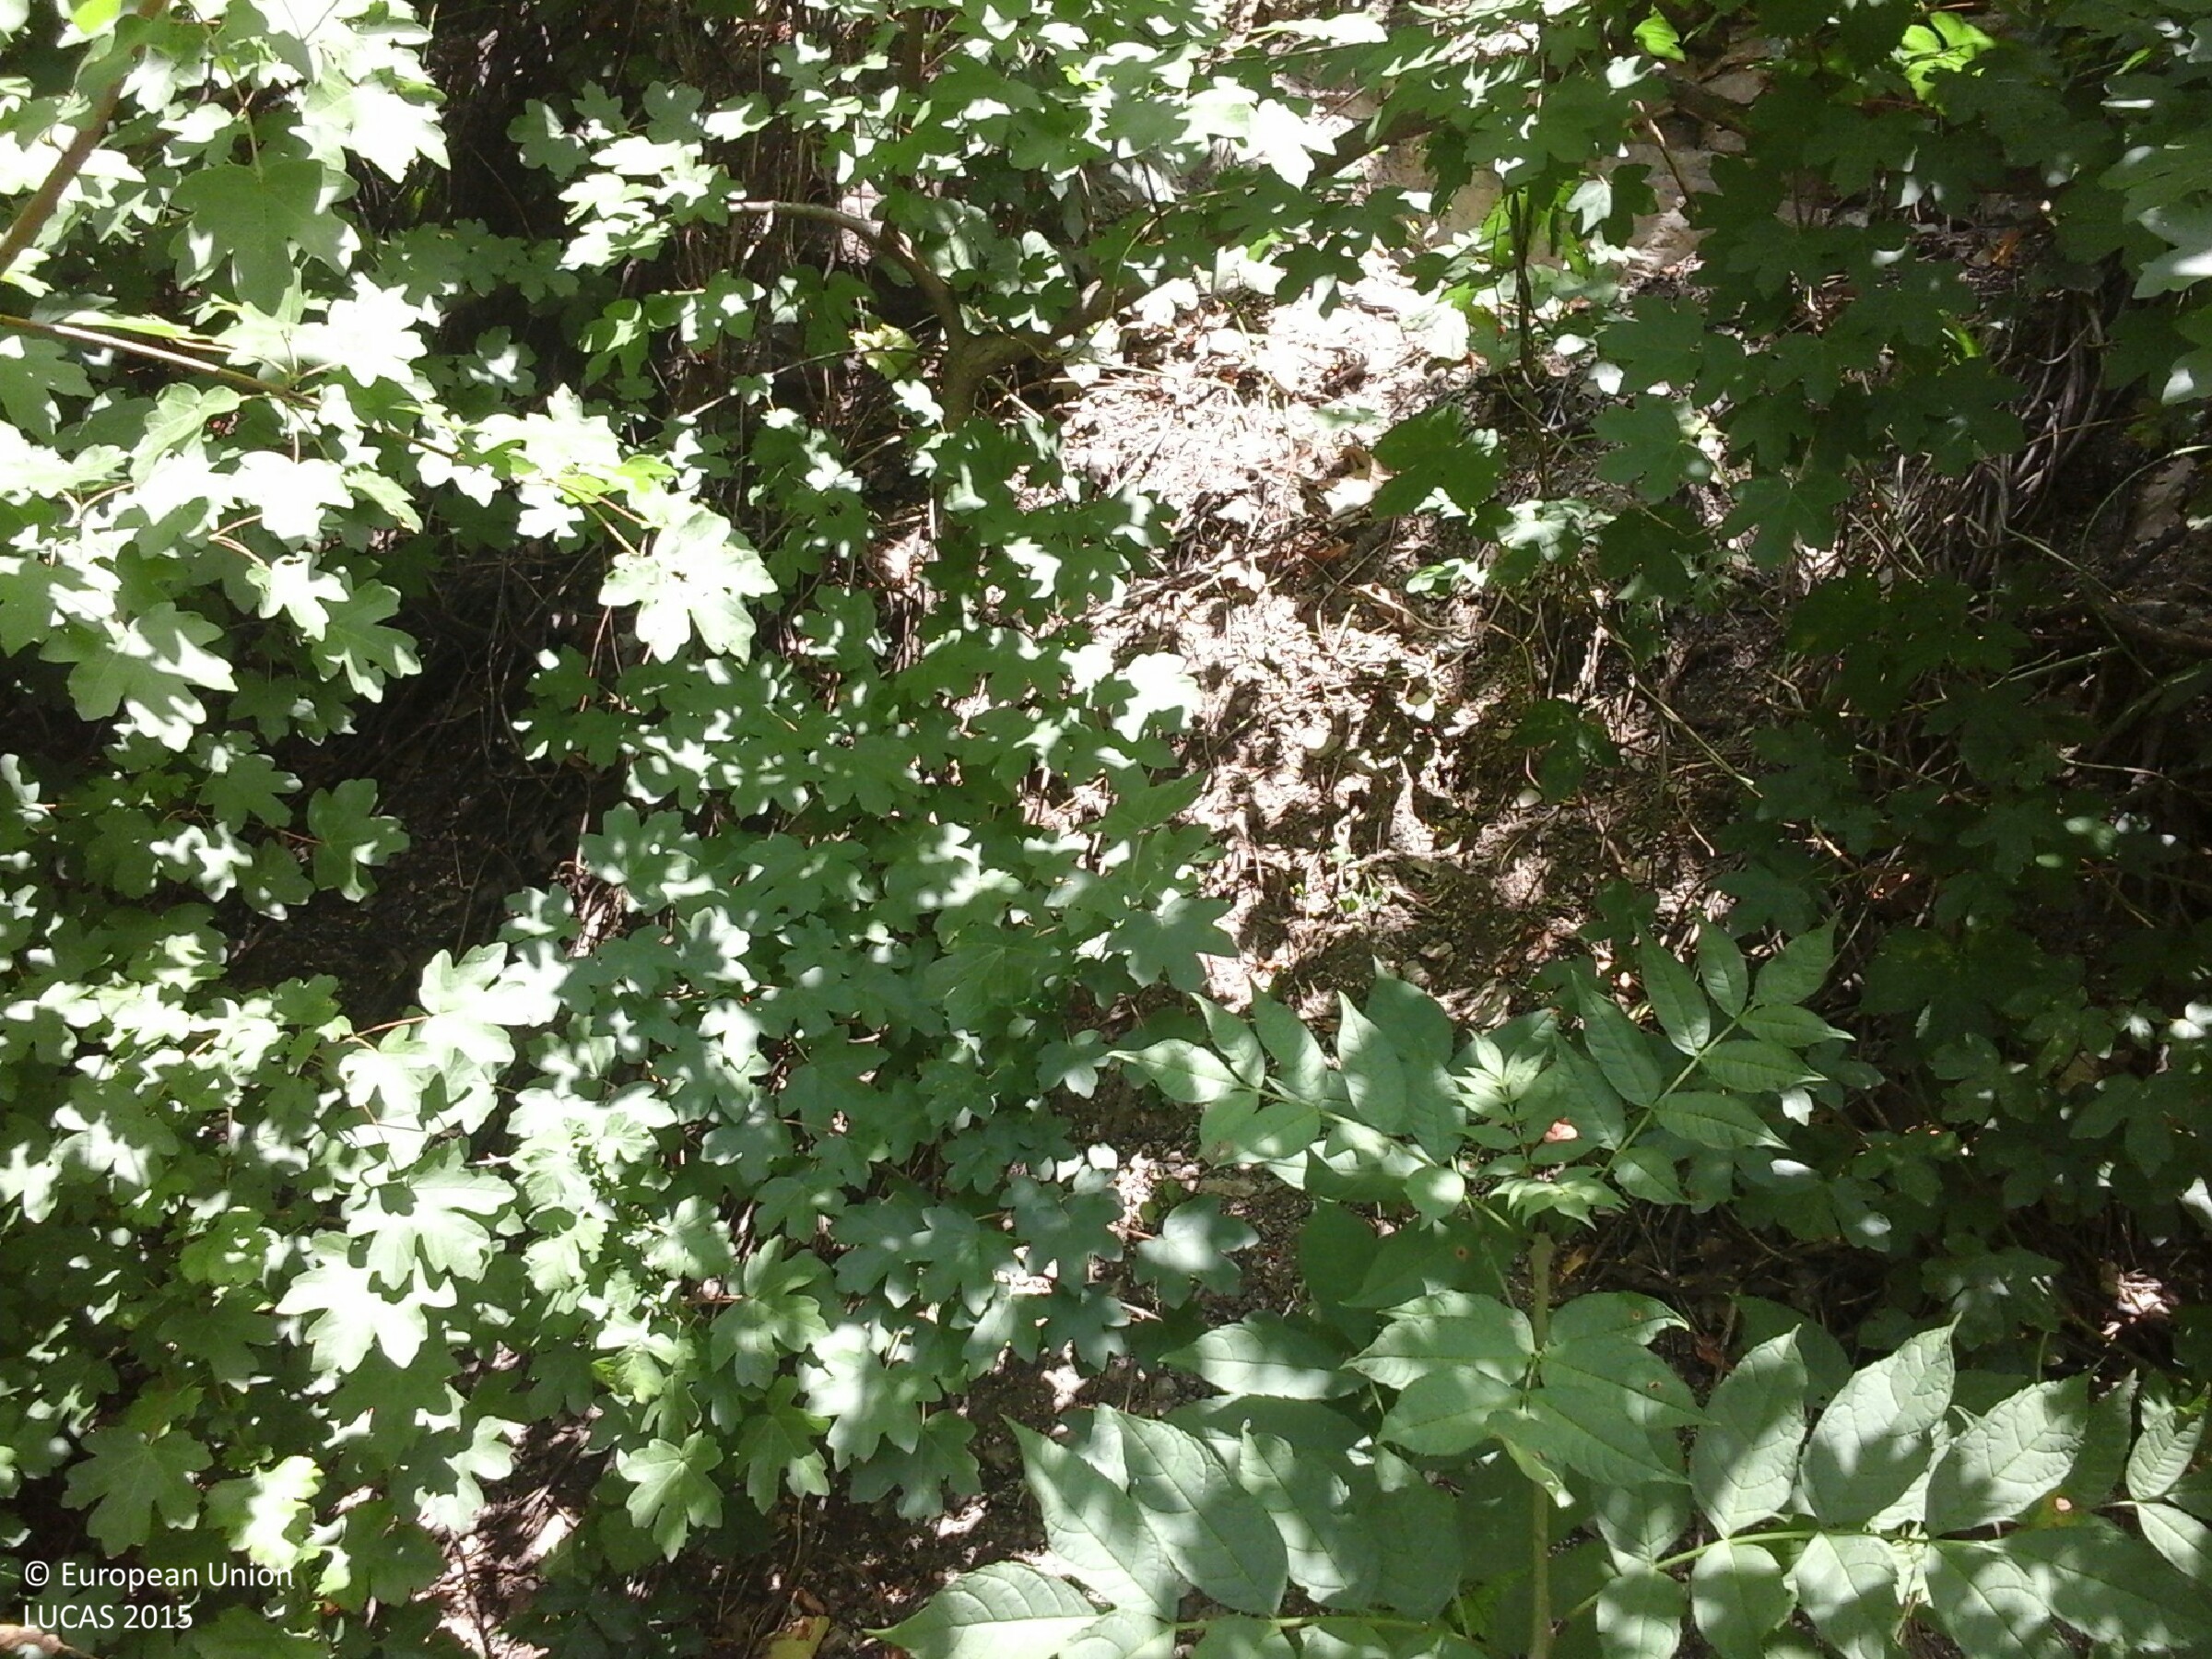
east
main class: Woodland
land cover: Broadleaved woodland
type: mesophytic deciduous forest
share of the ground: > 75 %
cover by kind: broadleaved forest trees 75 %, shrubs 20 %, herbaceous plants 5 %
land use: Forestry
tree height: > 5 m
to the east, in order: Broadleaved woodland; Rocks and stones; Broadleaved woodland
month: July
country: HU
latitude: 48.1072
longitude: 20.6315
